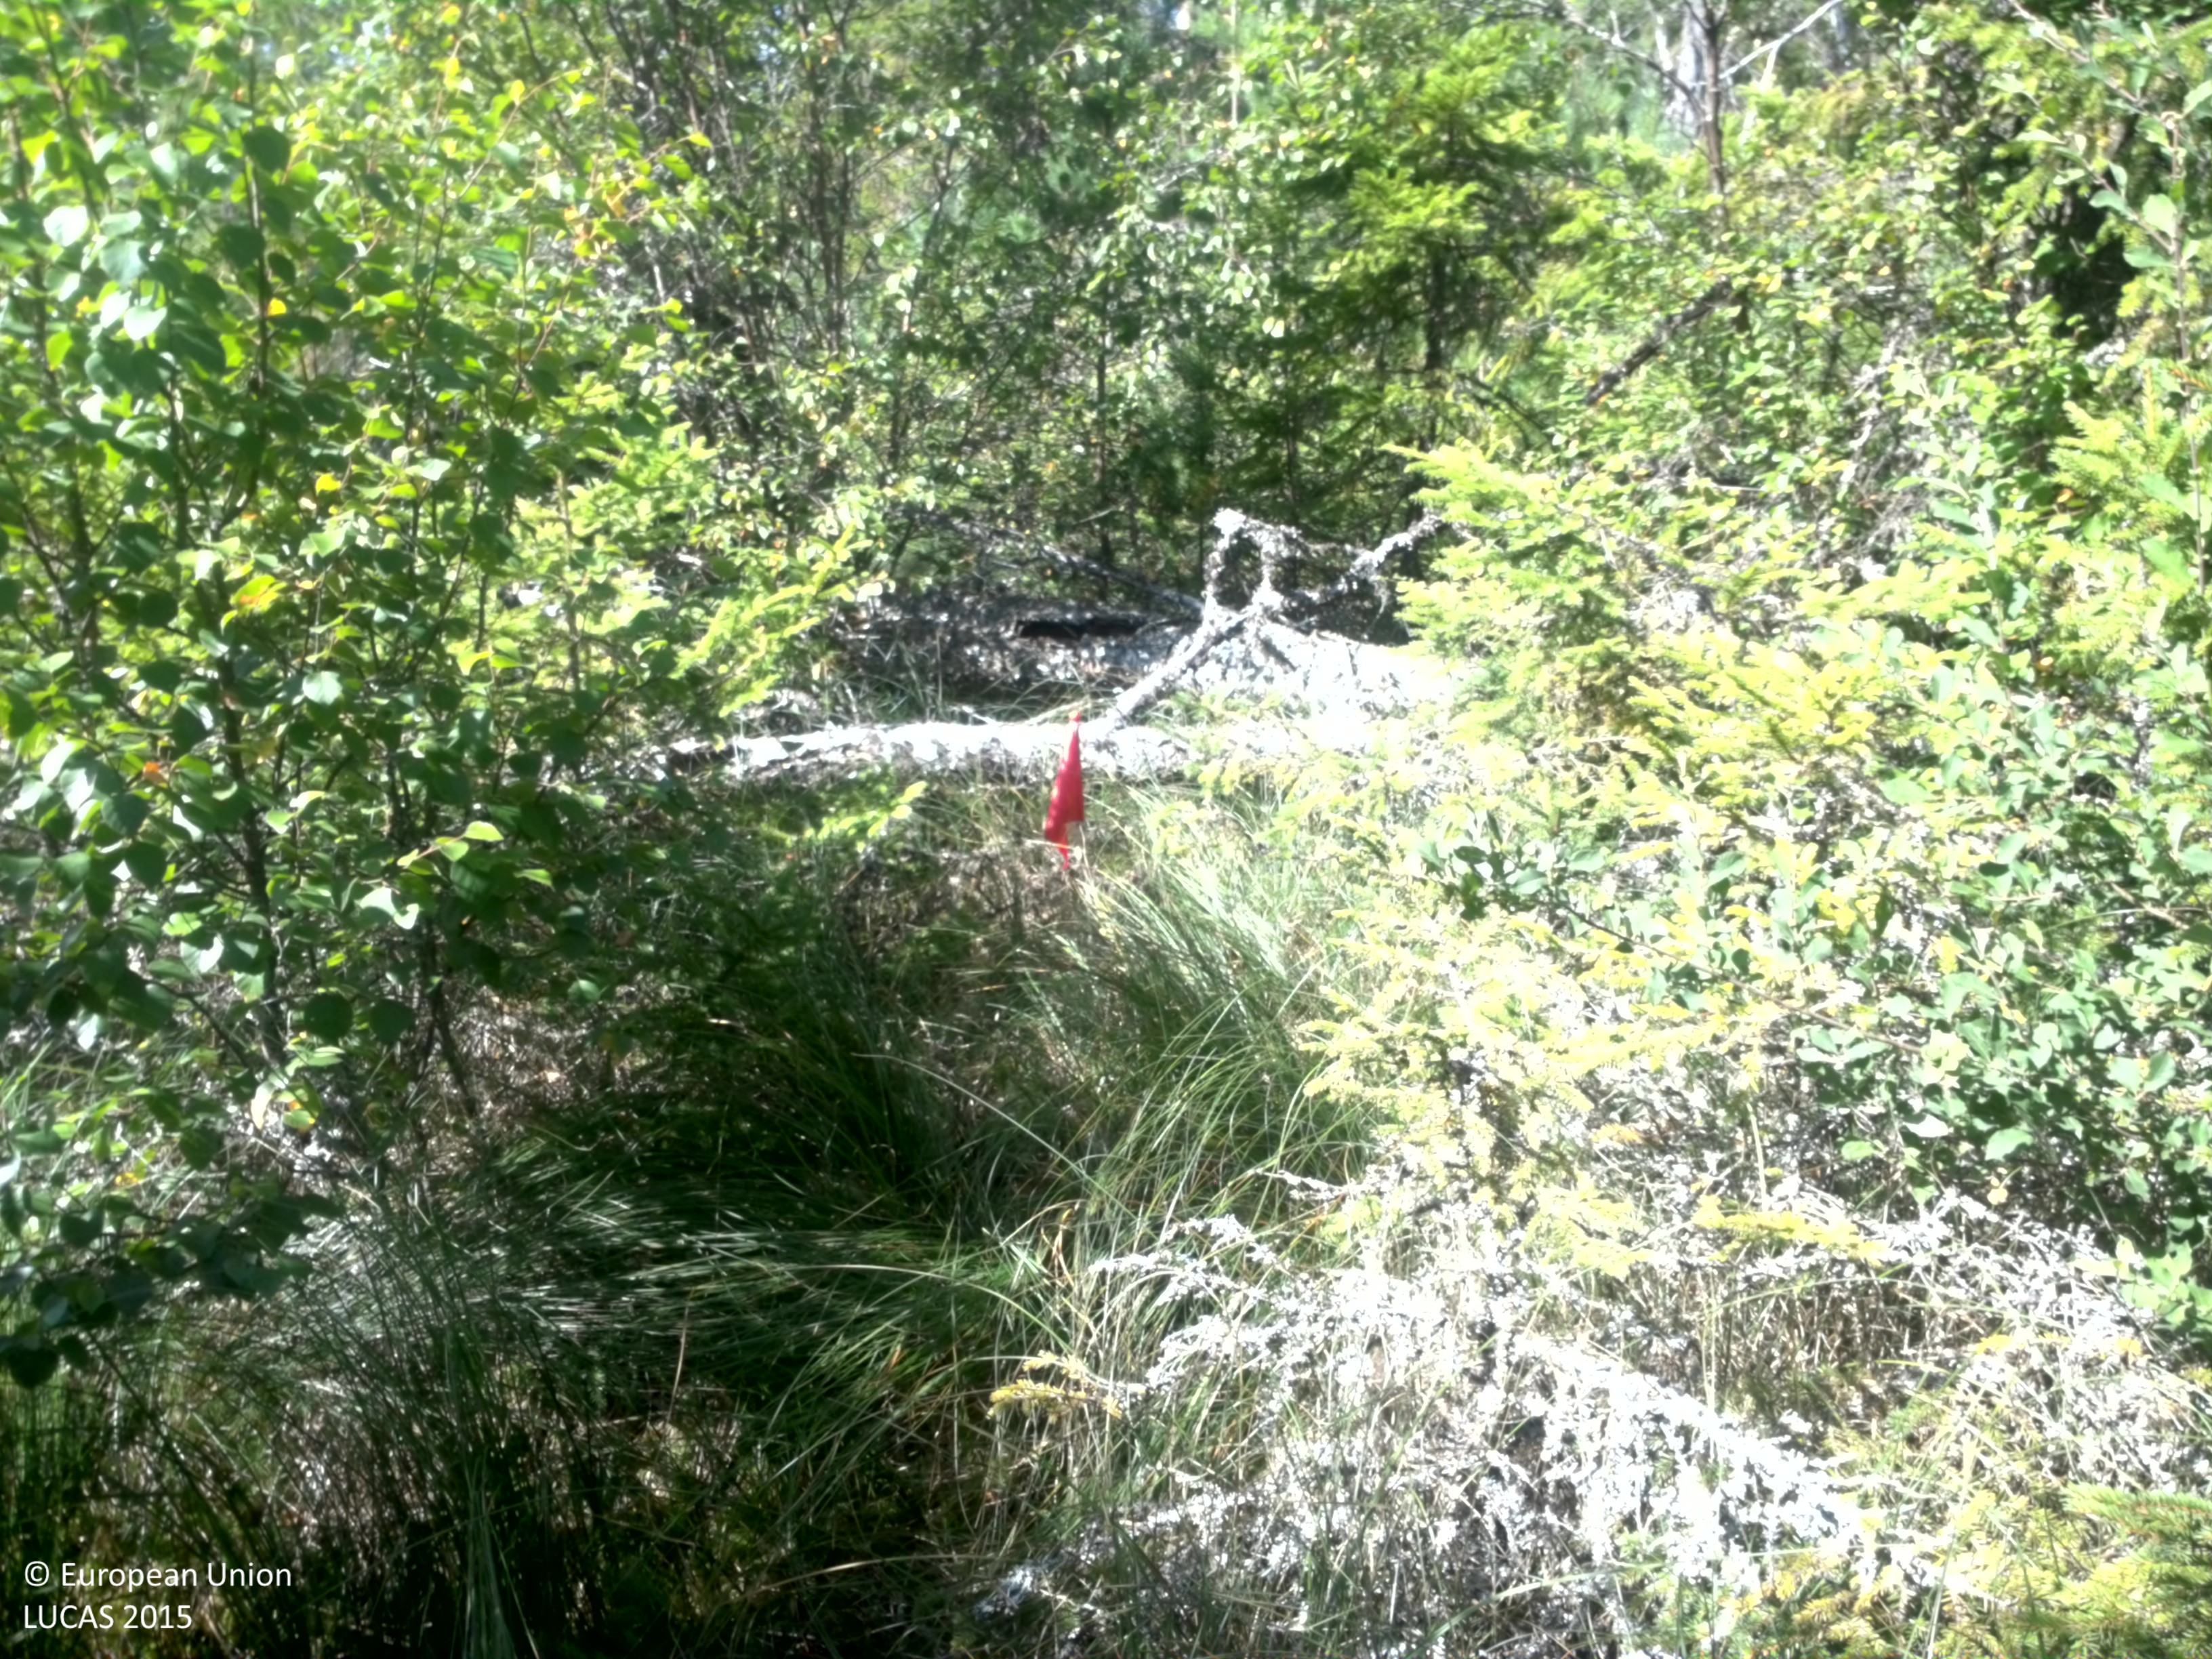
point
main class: Woodland
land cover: Spruce dominated mixed woodland
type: boreal forest
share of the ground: 50 - 75 %
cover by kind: lichens and mosses 40 %, coniferous forest trees 35 %, broadleaved forest trees 20 %, herbaceous plants 5 %
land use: Forestry
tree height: < 5 m
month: August
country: SE
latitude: 58.0938
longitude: 13.0992
